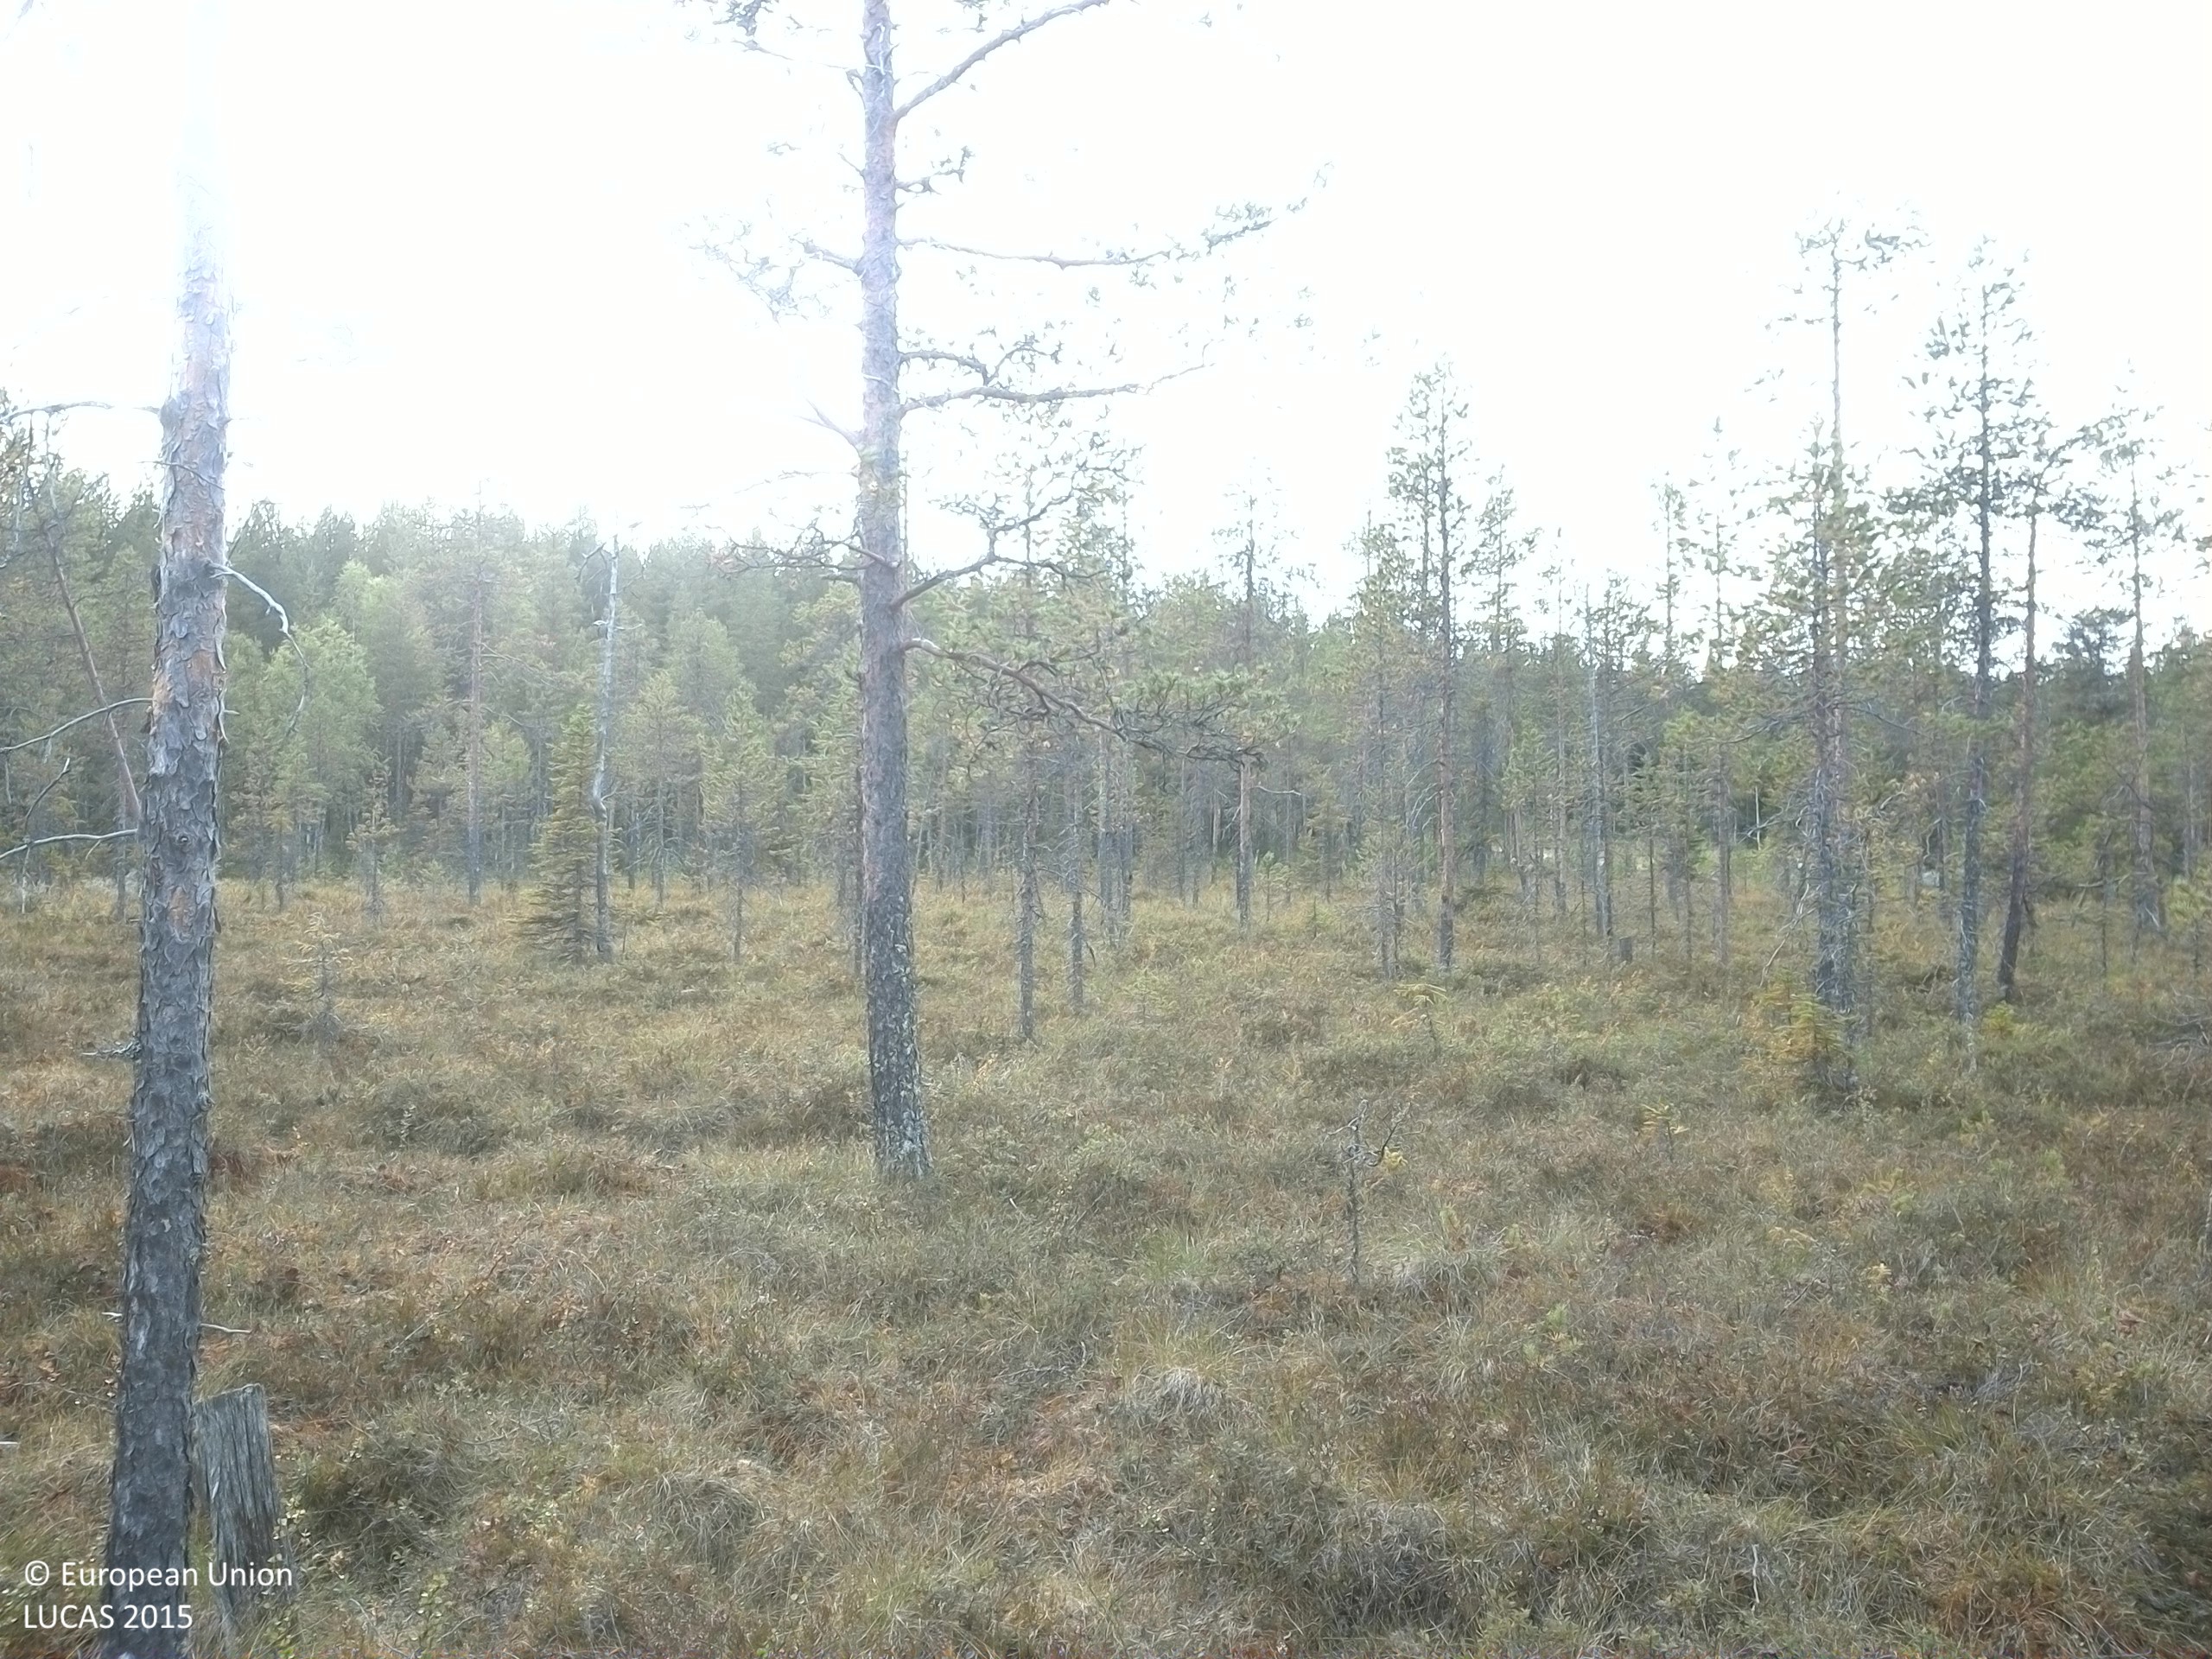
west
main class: Woodland
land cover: Pine dominated coniferous woodland
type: boreal forest
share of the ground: 10 - 25 %
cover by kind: lichens and mosses 40 %, shrubs 30 %, coniferous forest trees 20 %, herbaceous plants 10 %
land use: Semi-natural and natural areas not in use
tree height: > 5 m
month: September
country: SE
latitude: 64.0302
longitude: 17.6870
